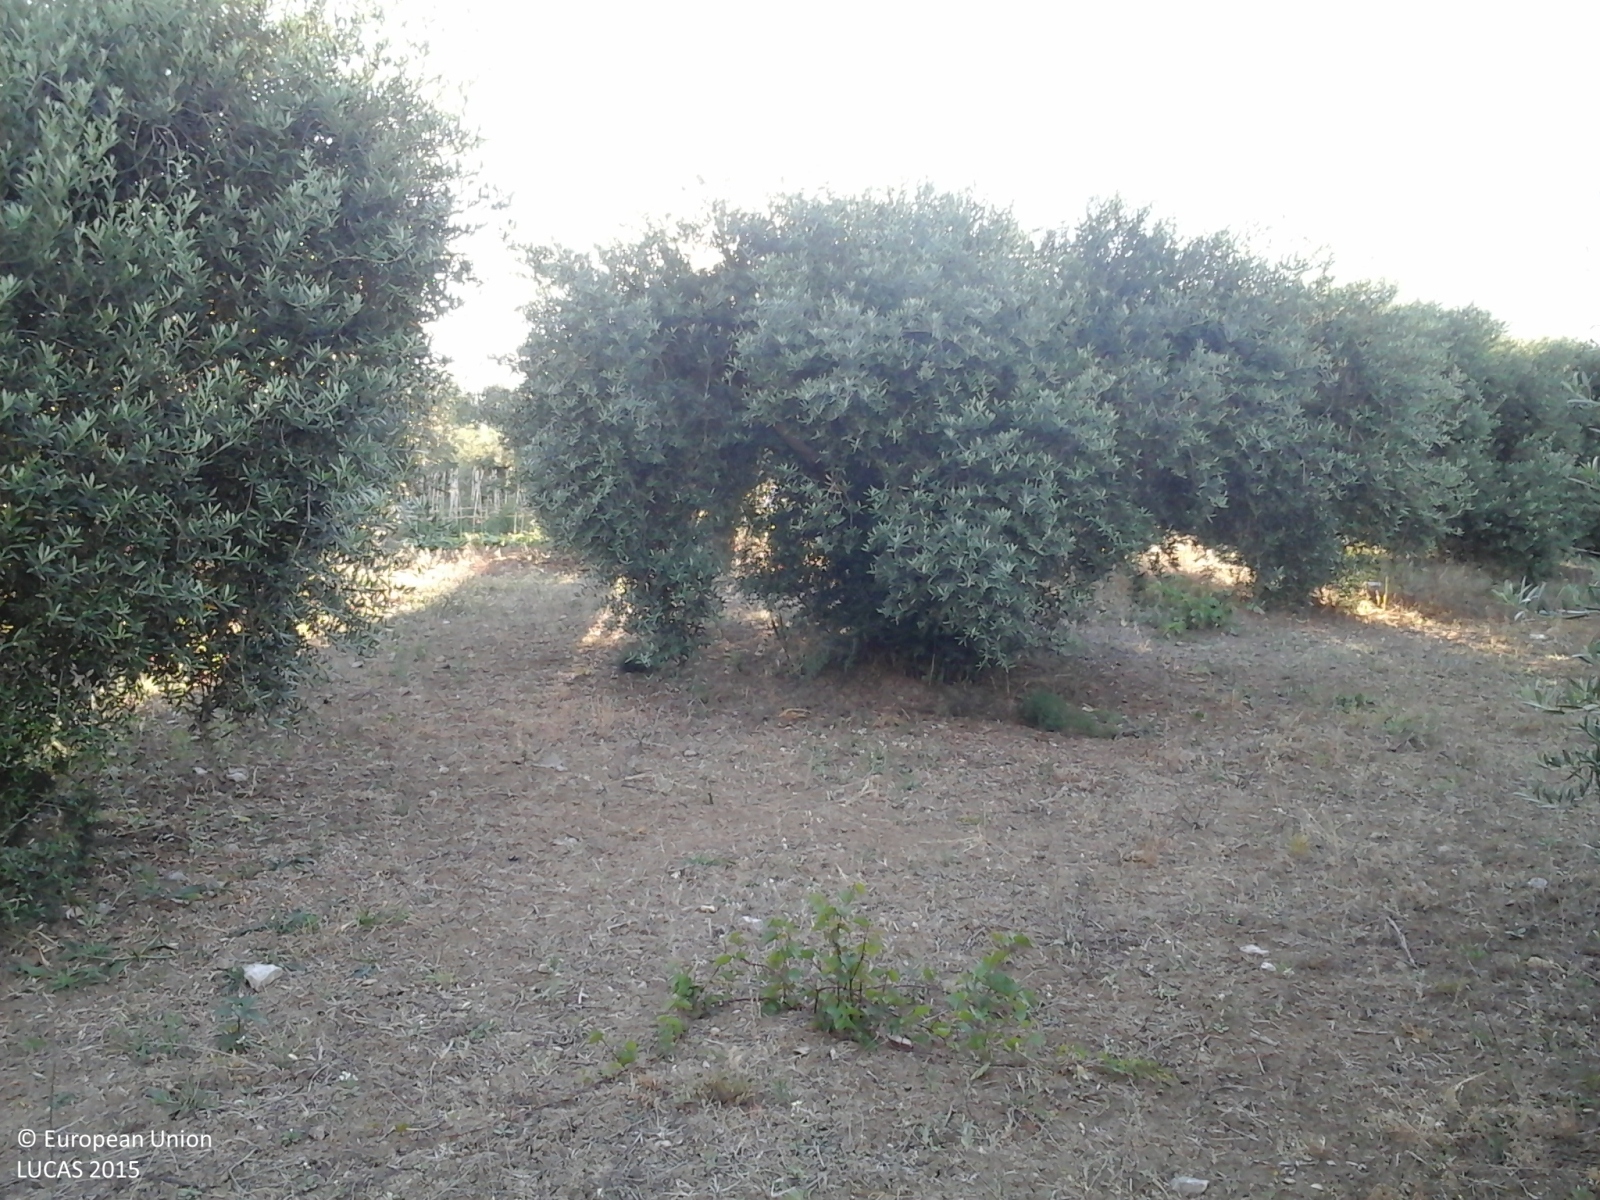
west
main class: Cropland
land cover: Olive groves
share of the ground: 50 - 75 %
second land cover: Spontaneously vegetated surfaces
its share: > 75 %
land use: Agriculture (excluding fallow land and kitchen gardens)
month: June
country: IT
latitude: 38.0276
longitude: 13.5182
